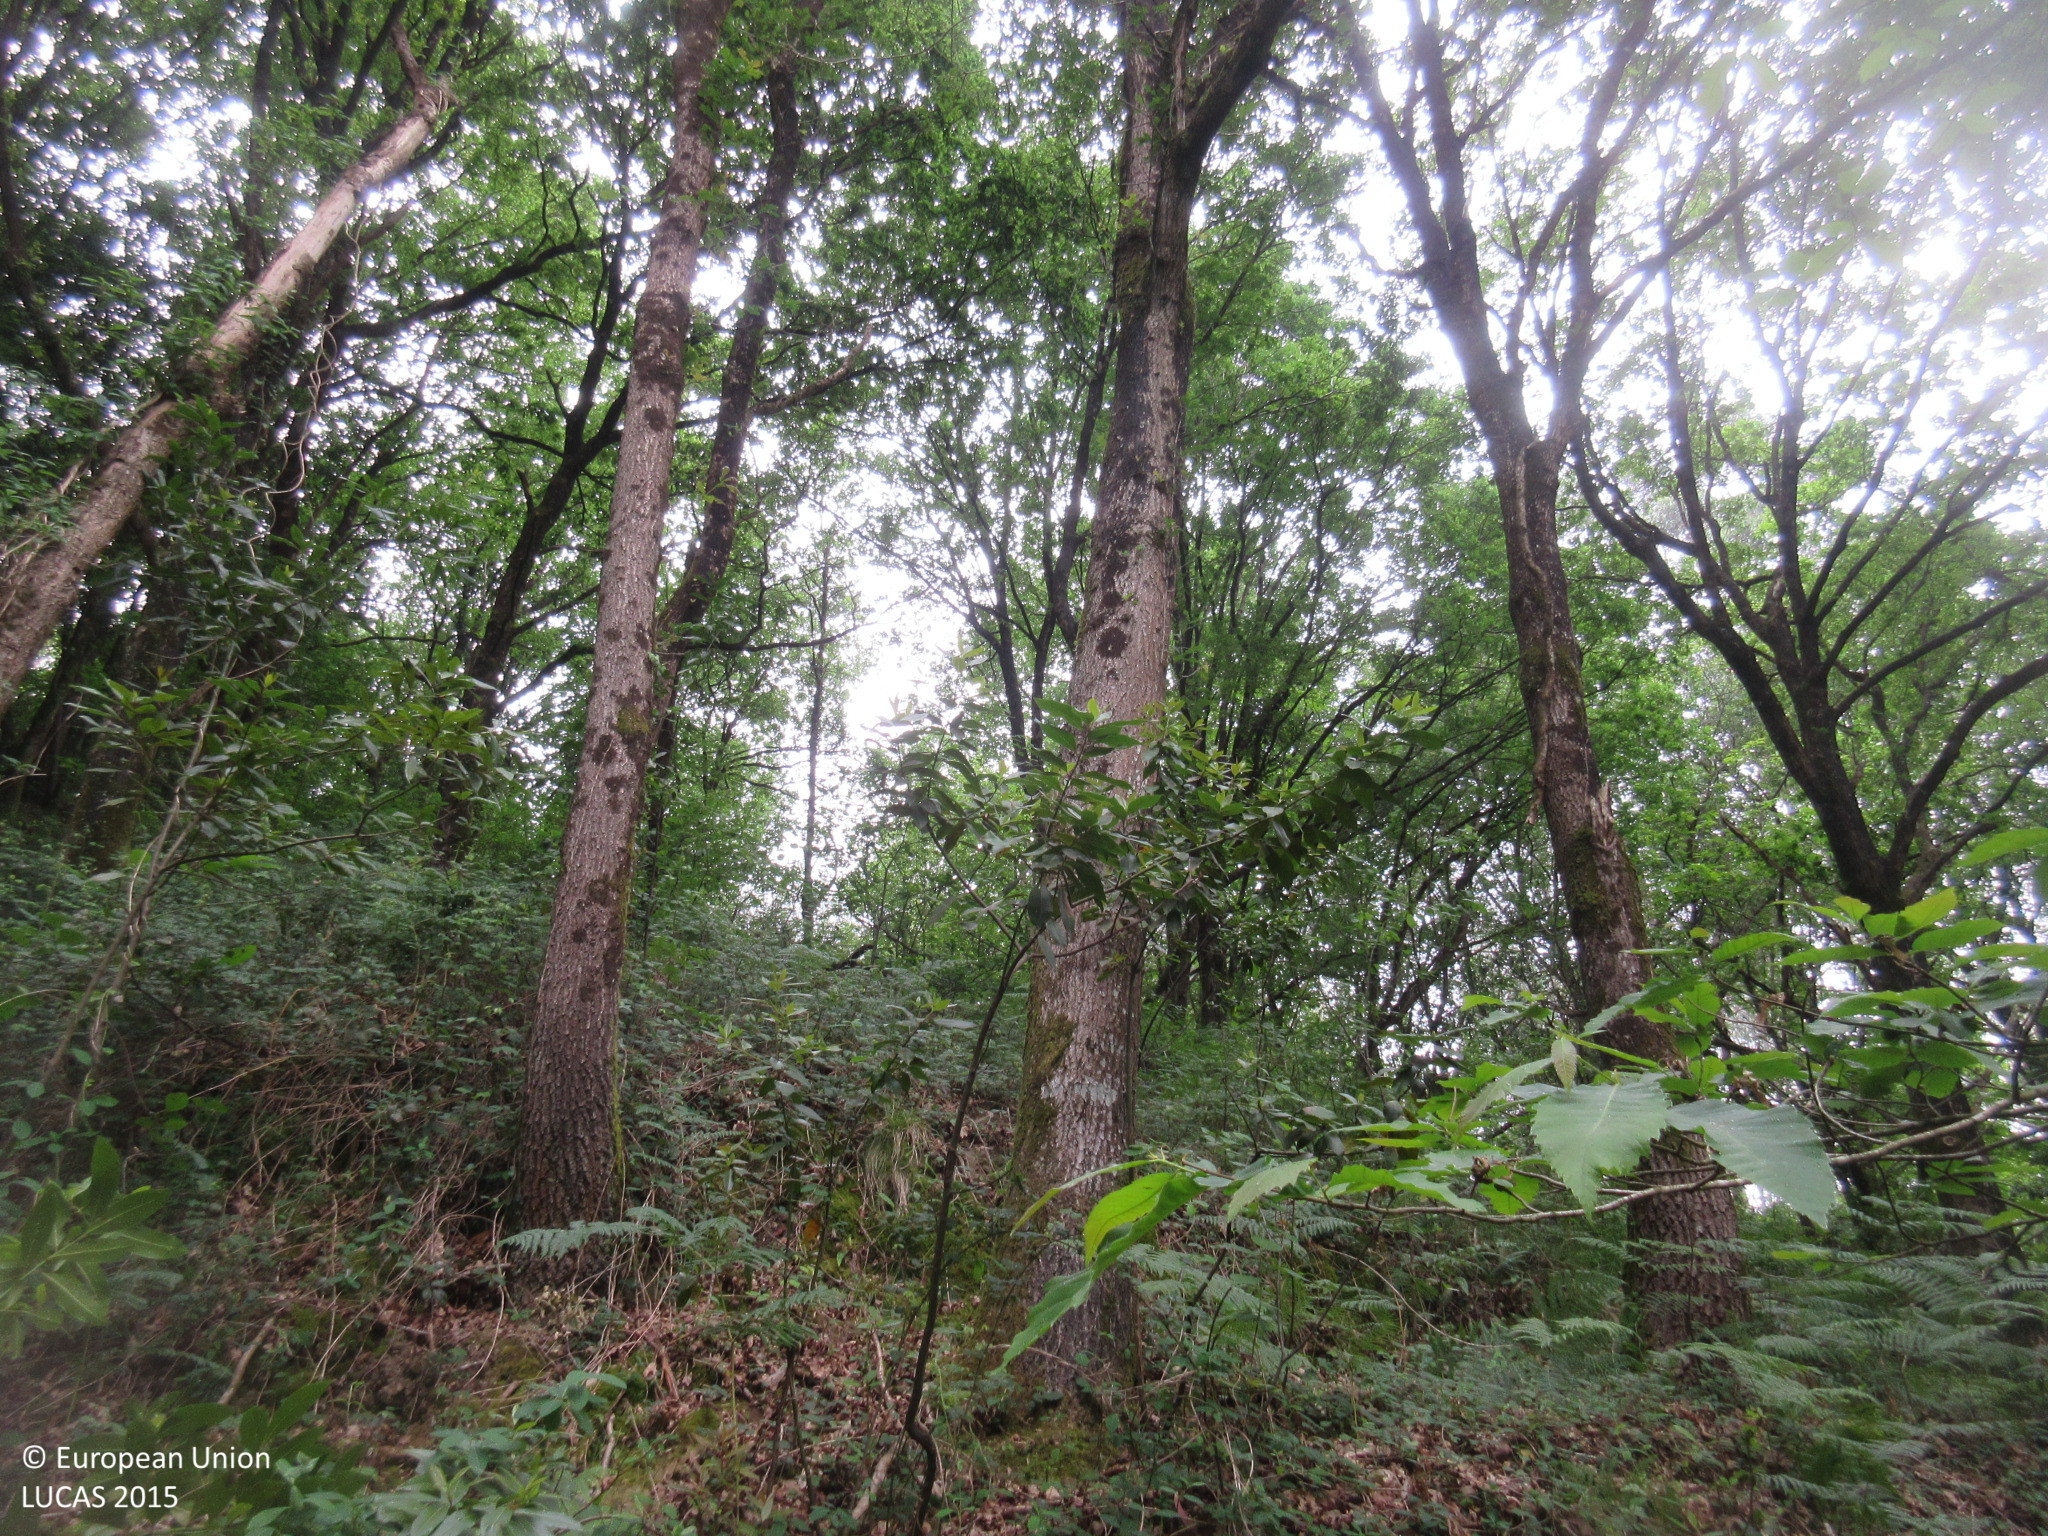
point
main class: Woodland
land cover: Broadleaved woodland
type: thermophilous deciduous forest
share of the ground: > 75 %
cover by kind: broadleaved forest trees 95 %, shrubs 5 %
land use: Forestry
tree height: > 5 m
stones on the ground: < 10 %
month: June
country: ES
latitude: 43.3456
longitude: -3.4267
